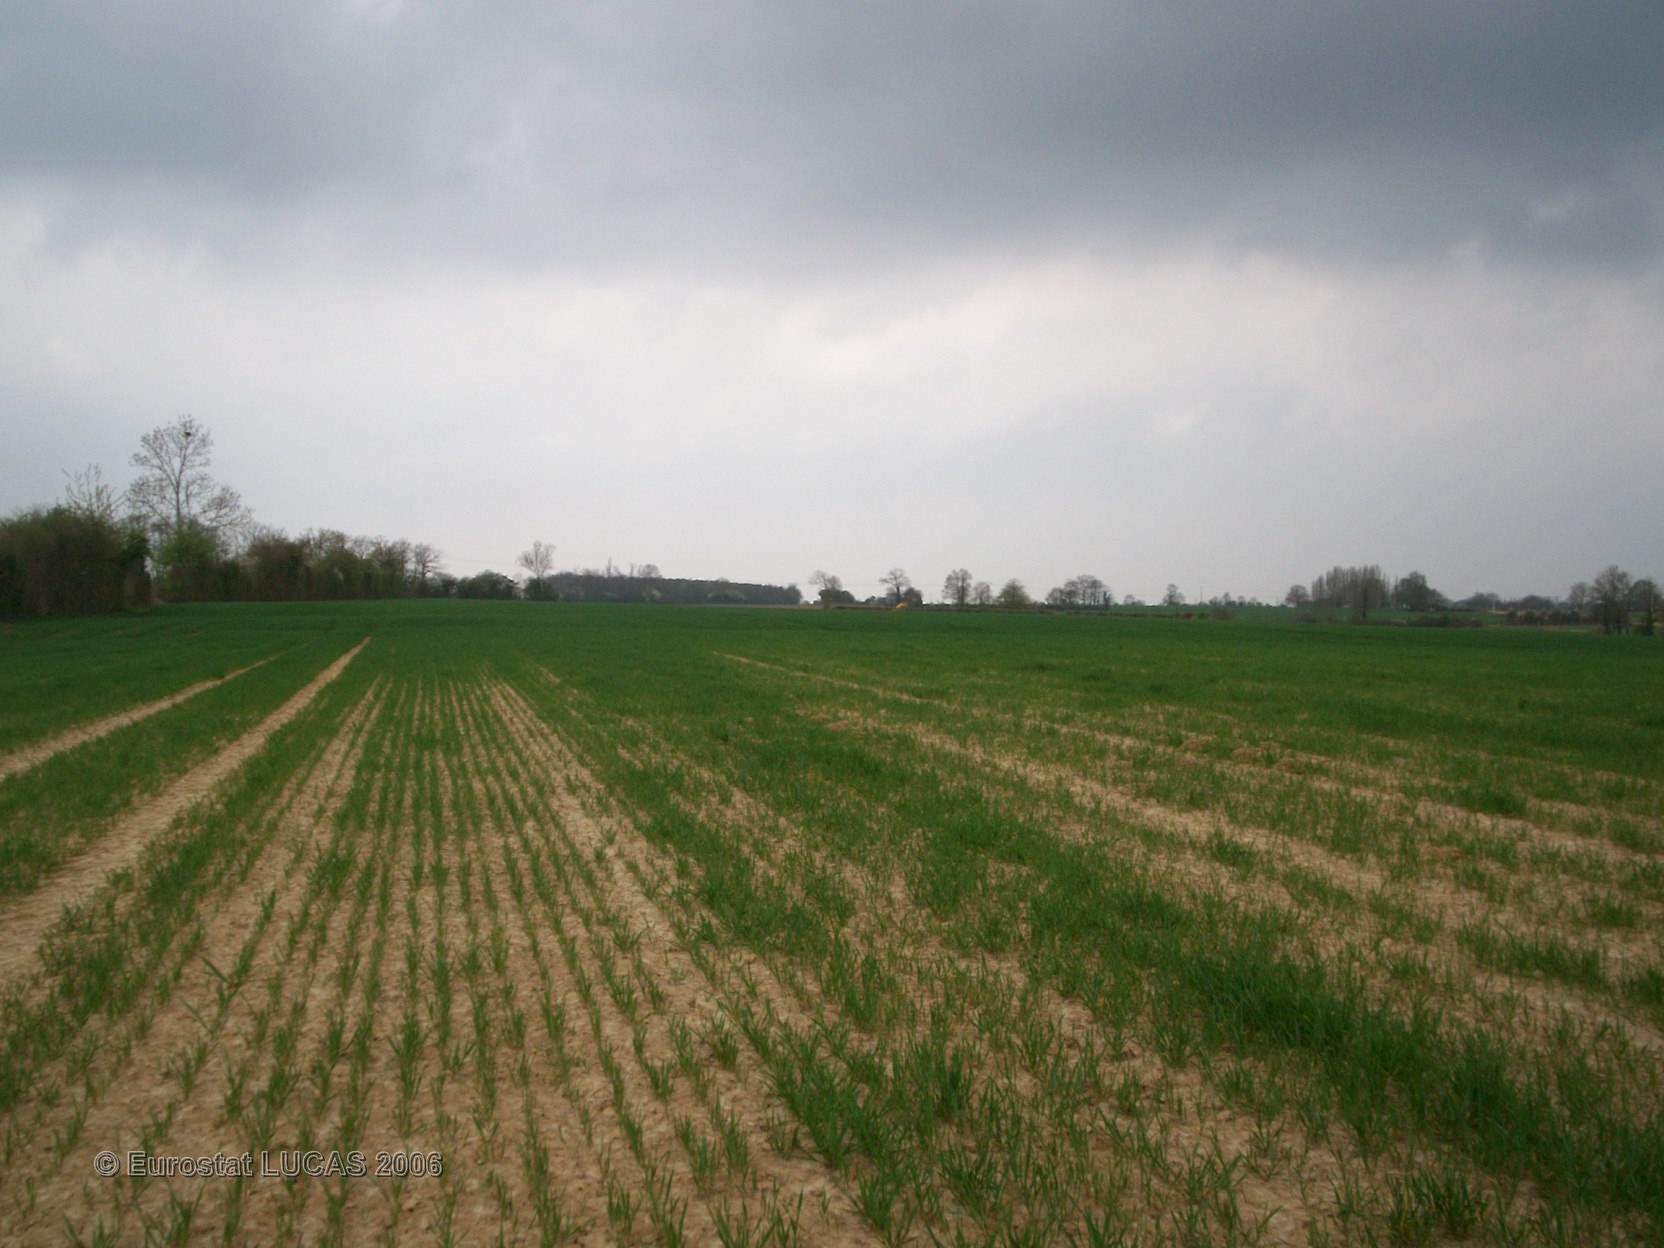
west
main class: Cropland
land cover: Common wheat
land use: Agriculture (excluding fallow land and kitchen gardens)
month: April
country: FR
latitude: 48.6780
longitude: 0.0424
